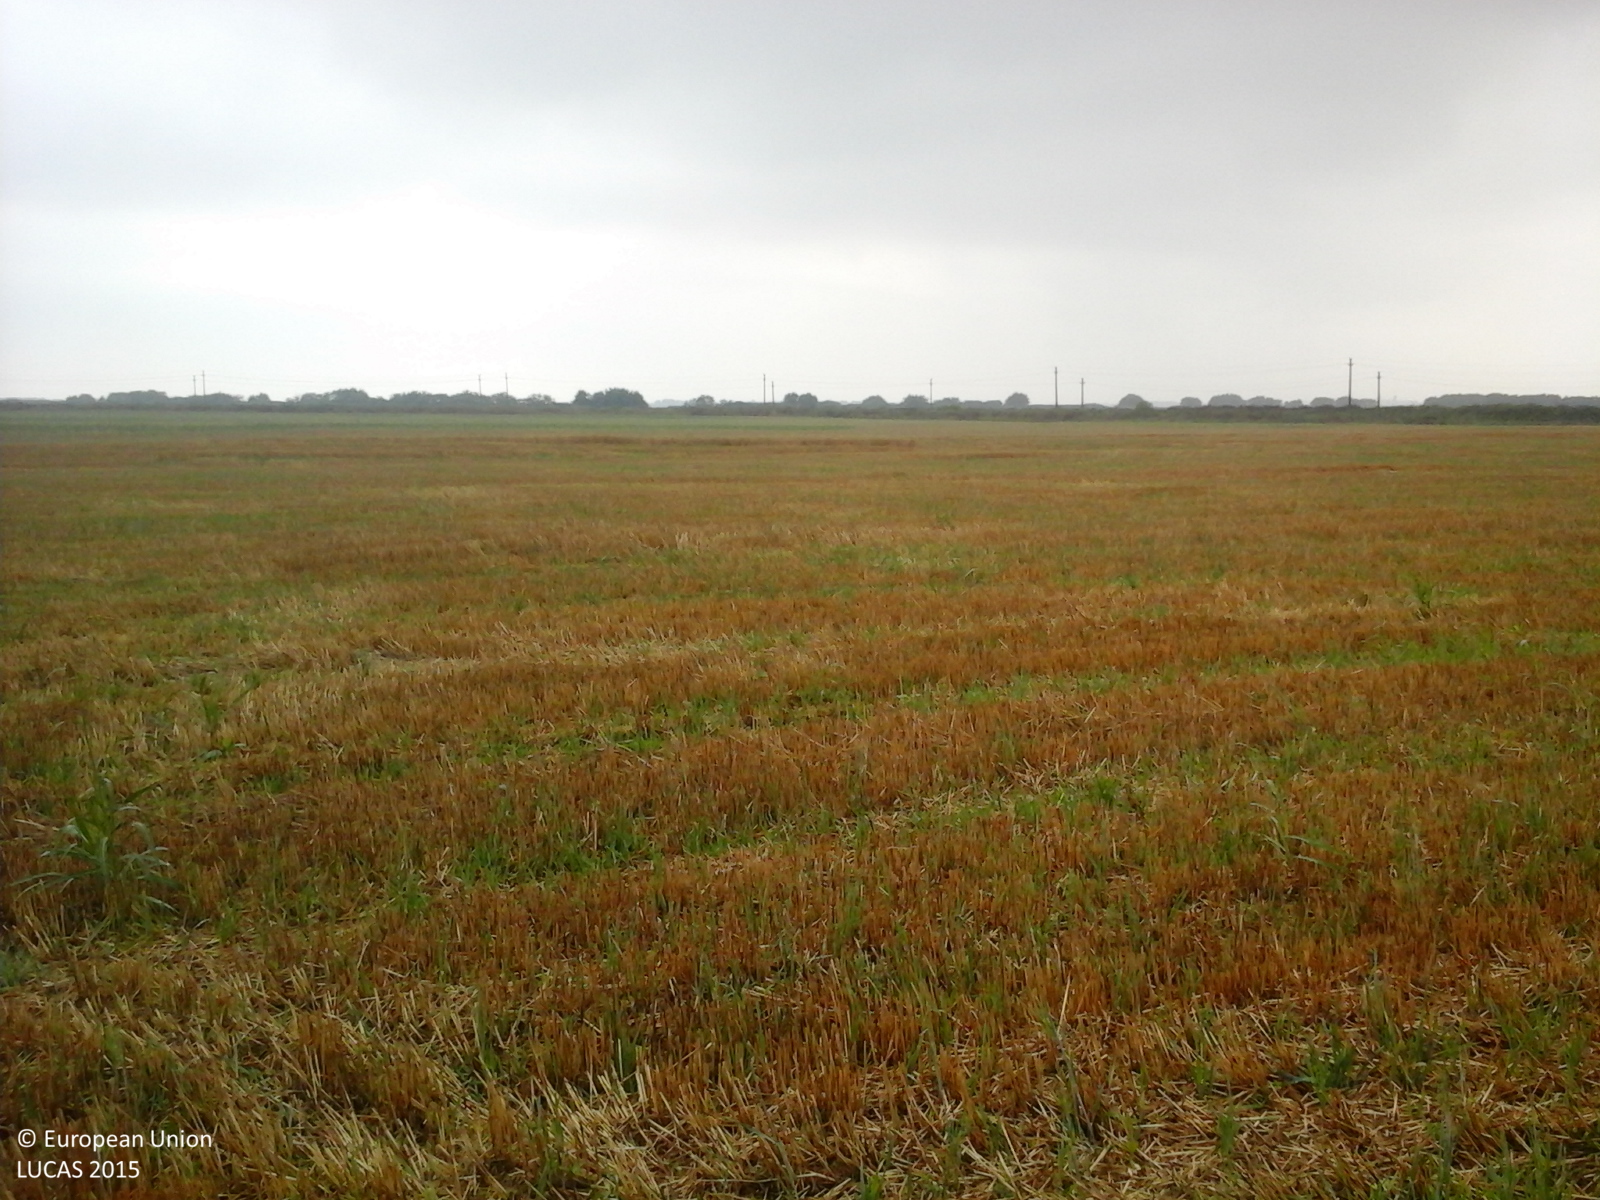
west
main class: Cropland
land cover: Durum wheat
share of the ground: < 10 %
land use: Agriculture (excluding fallow land and kitchen gardens)
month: August
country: RO
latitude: 46.1775
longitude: 20.5047
